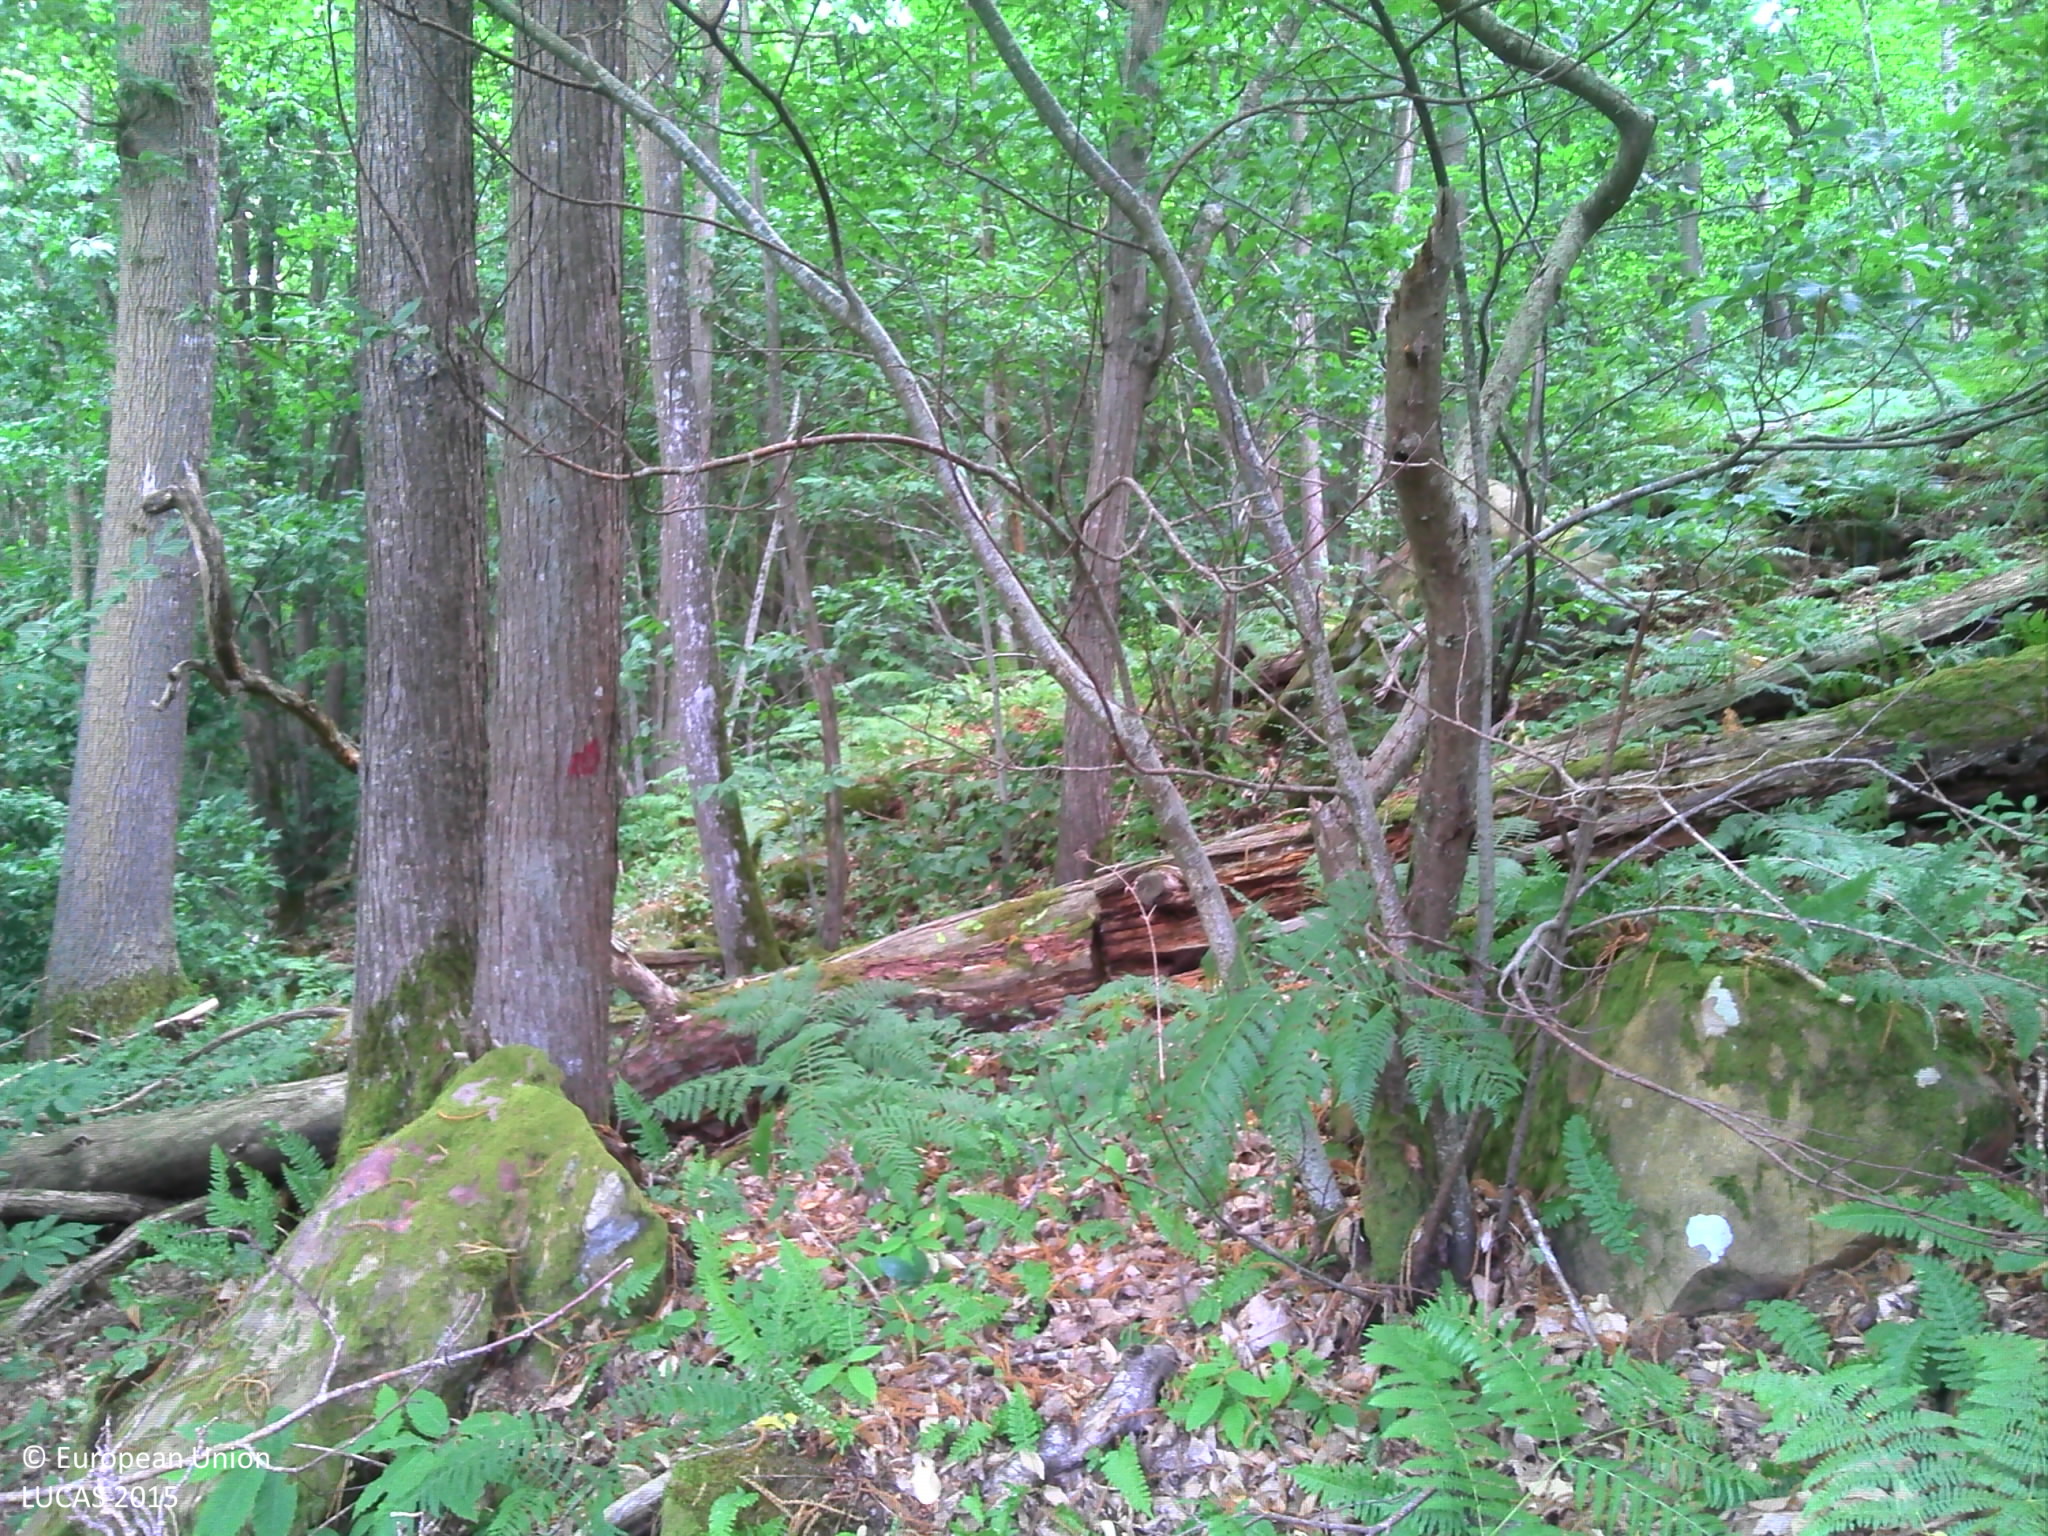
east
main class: Woodland
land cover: Broadleaved woodland
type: thermophilous deciduous forest
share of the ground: > 75 %
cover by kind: broadleaved forest trees 55 %, lichens and mosses 15 %, shrubs 10 %, herbaceous plants 10 %
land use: Forestry
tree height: > 5 m
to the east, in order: Broadleaved woodland
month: July
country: FR
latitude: 48.4190
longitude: 2.7618
